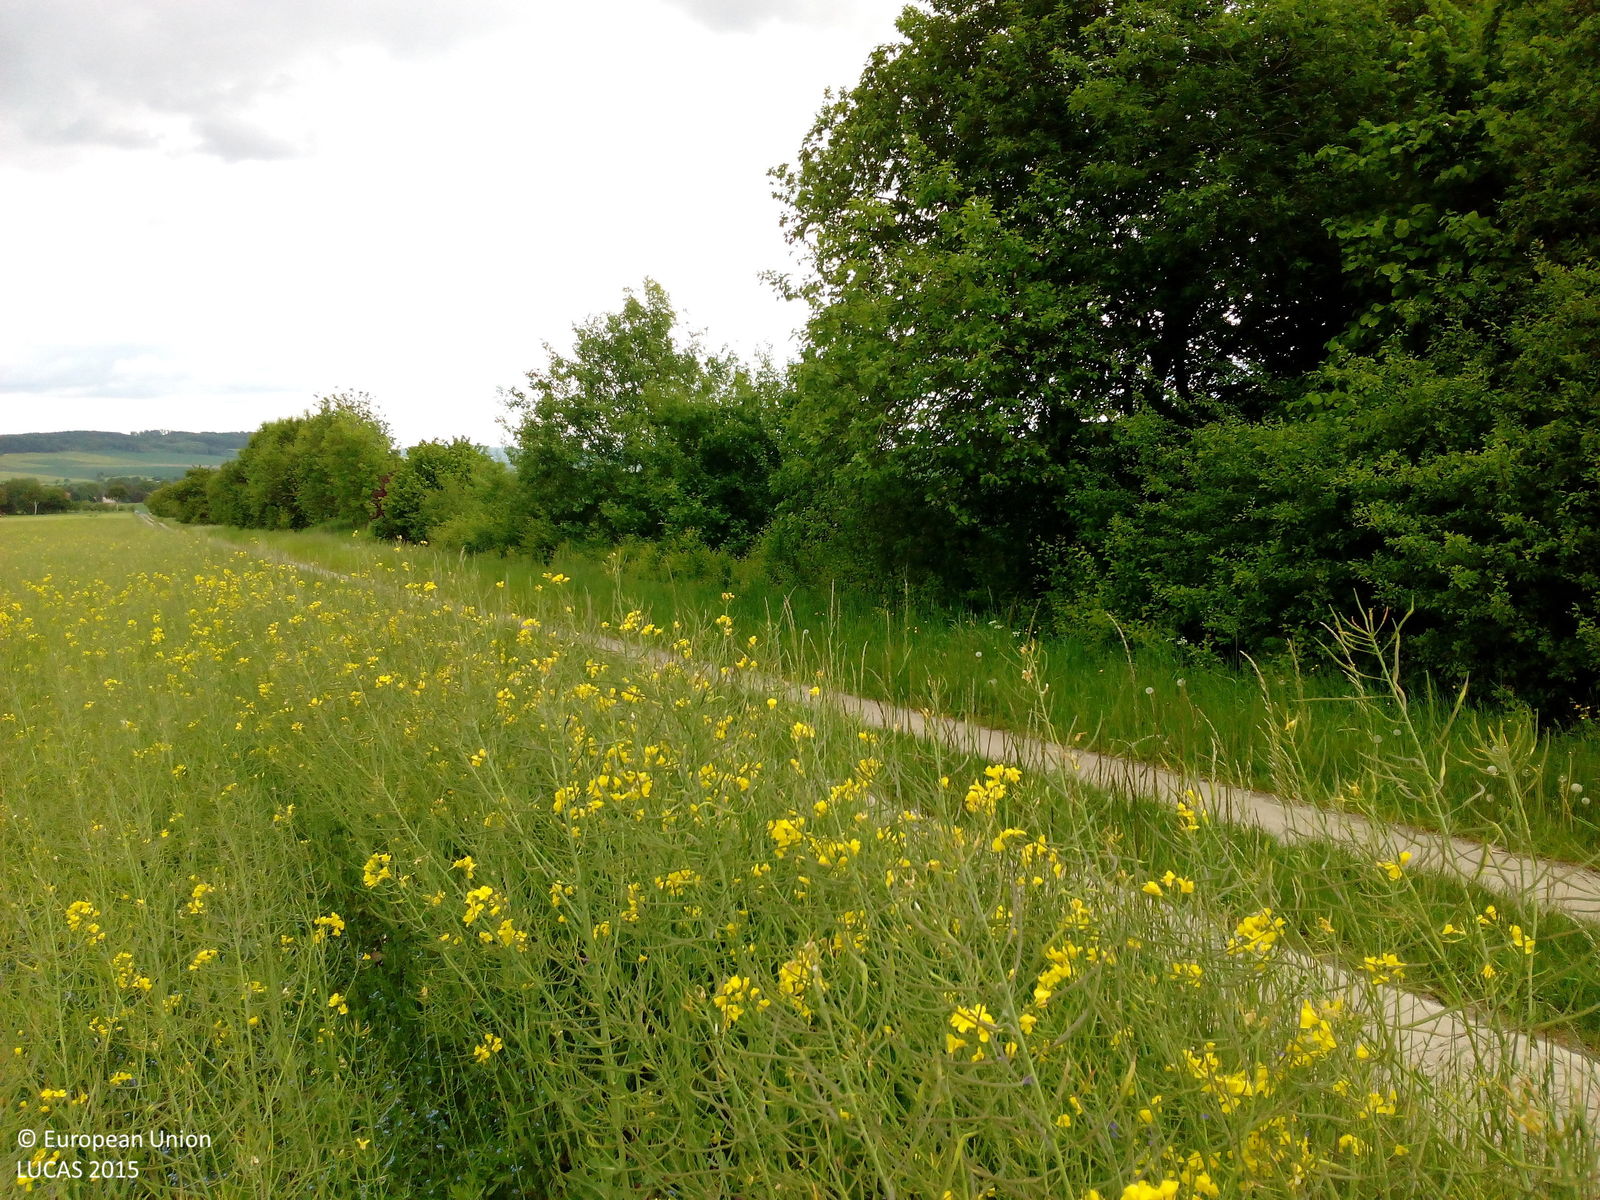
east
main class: Cropland
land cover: Rape and turnip rape
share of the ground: > 75 %
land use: Agriculture (excluding fallow land and kitchen gardens)
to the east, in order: Rape and turnip rape; Grass margins; Tracks; Grass margins; Abandoned hedges; Ditches and canals; Abandoned hedges; Grass margins; Common wheat
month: May
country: DE
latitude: 52.0359
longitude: 9.8980
